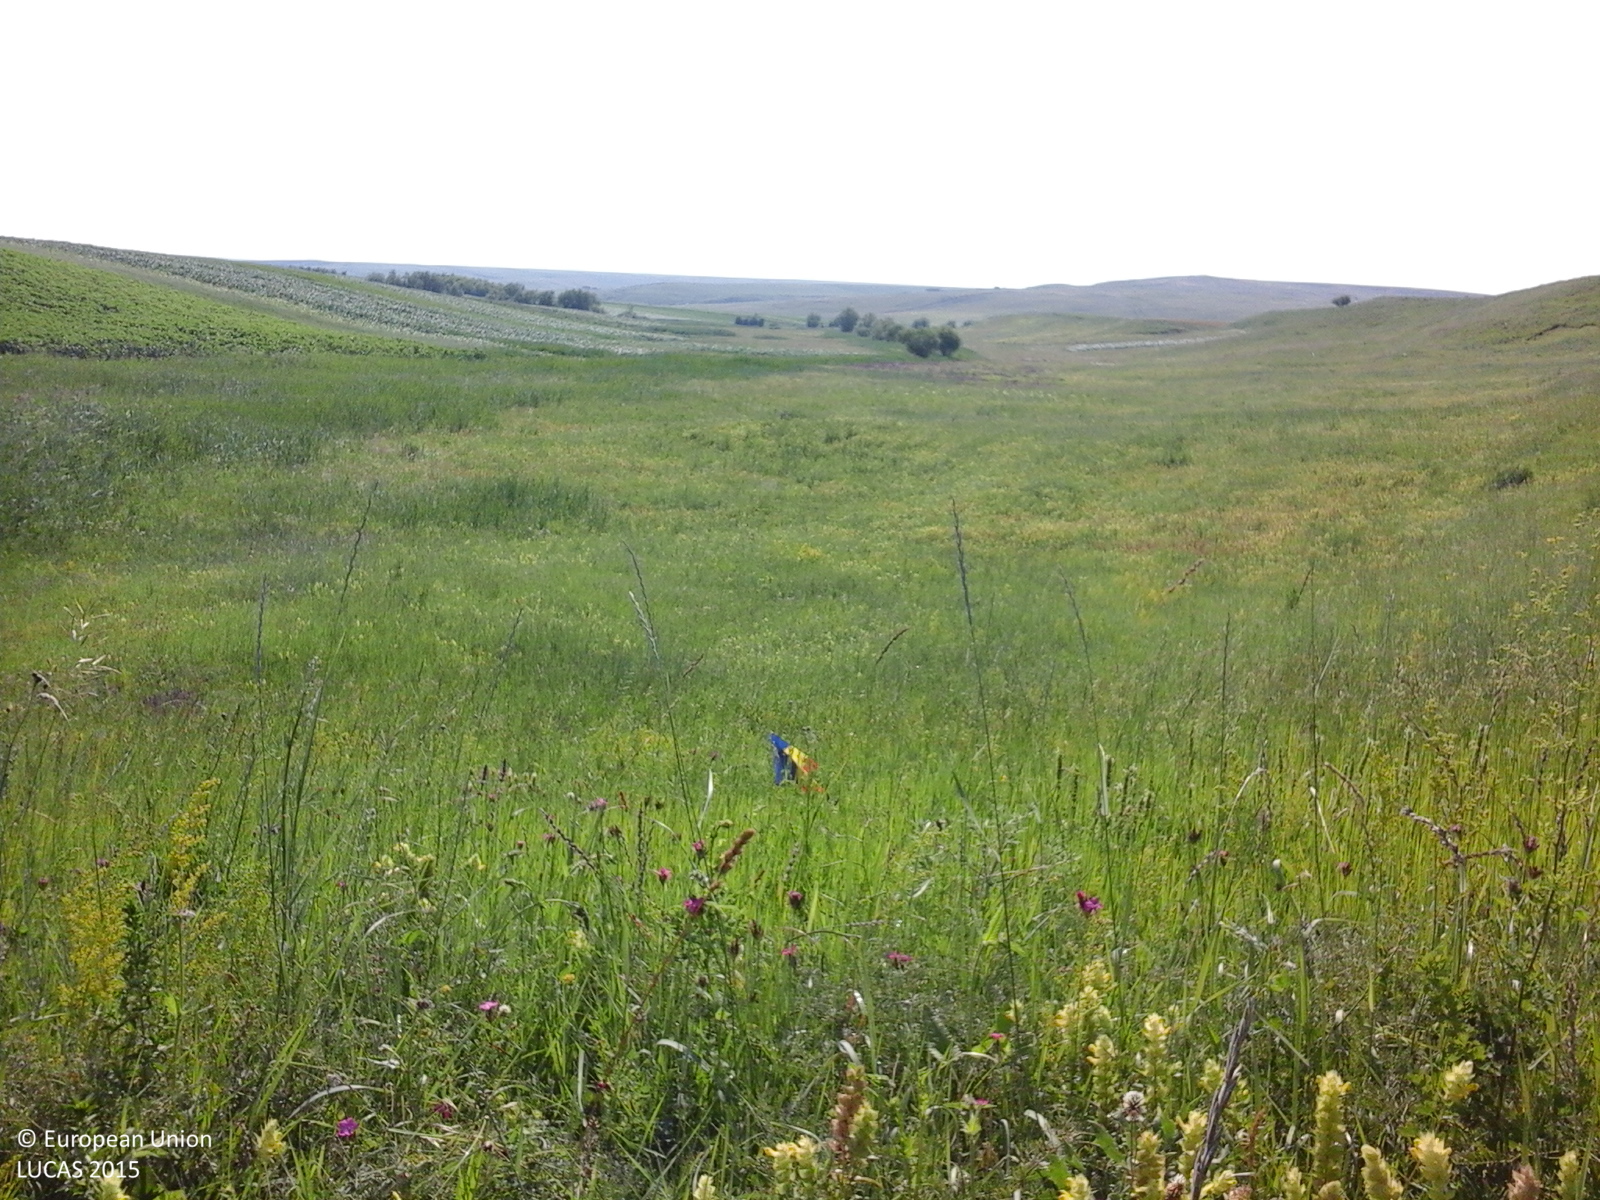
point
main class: Grassland
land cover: Grassland without tree/shrub cover
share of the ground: > 75 %
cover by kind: herbaceous plants 100 %
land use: Agriculture (excluding fallow land and kitchen gardens)
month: June
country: RO
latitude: 48.1046
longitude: 26.5177
